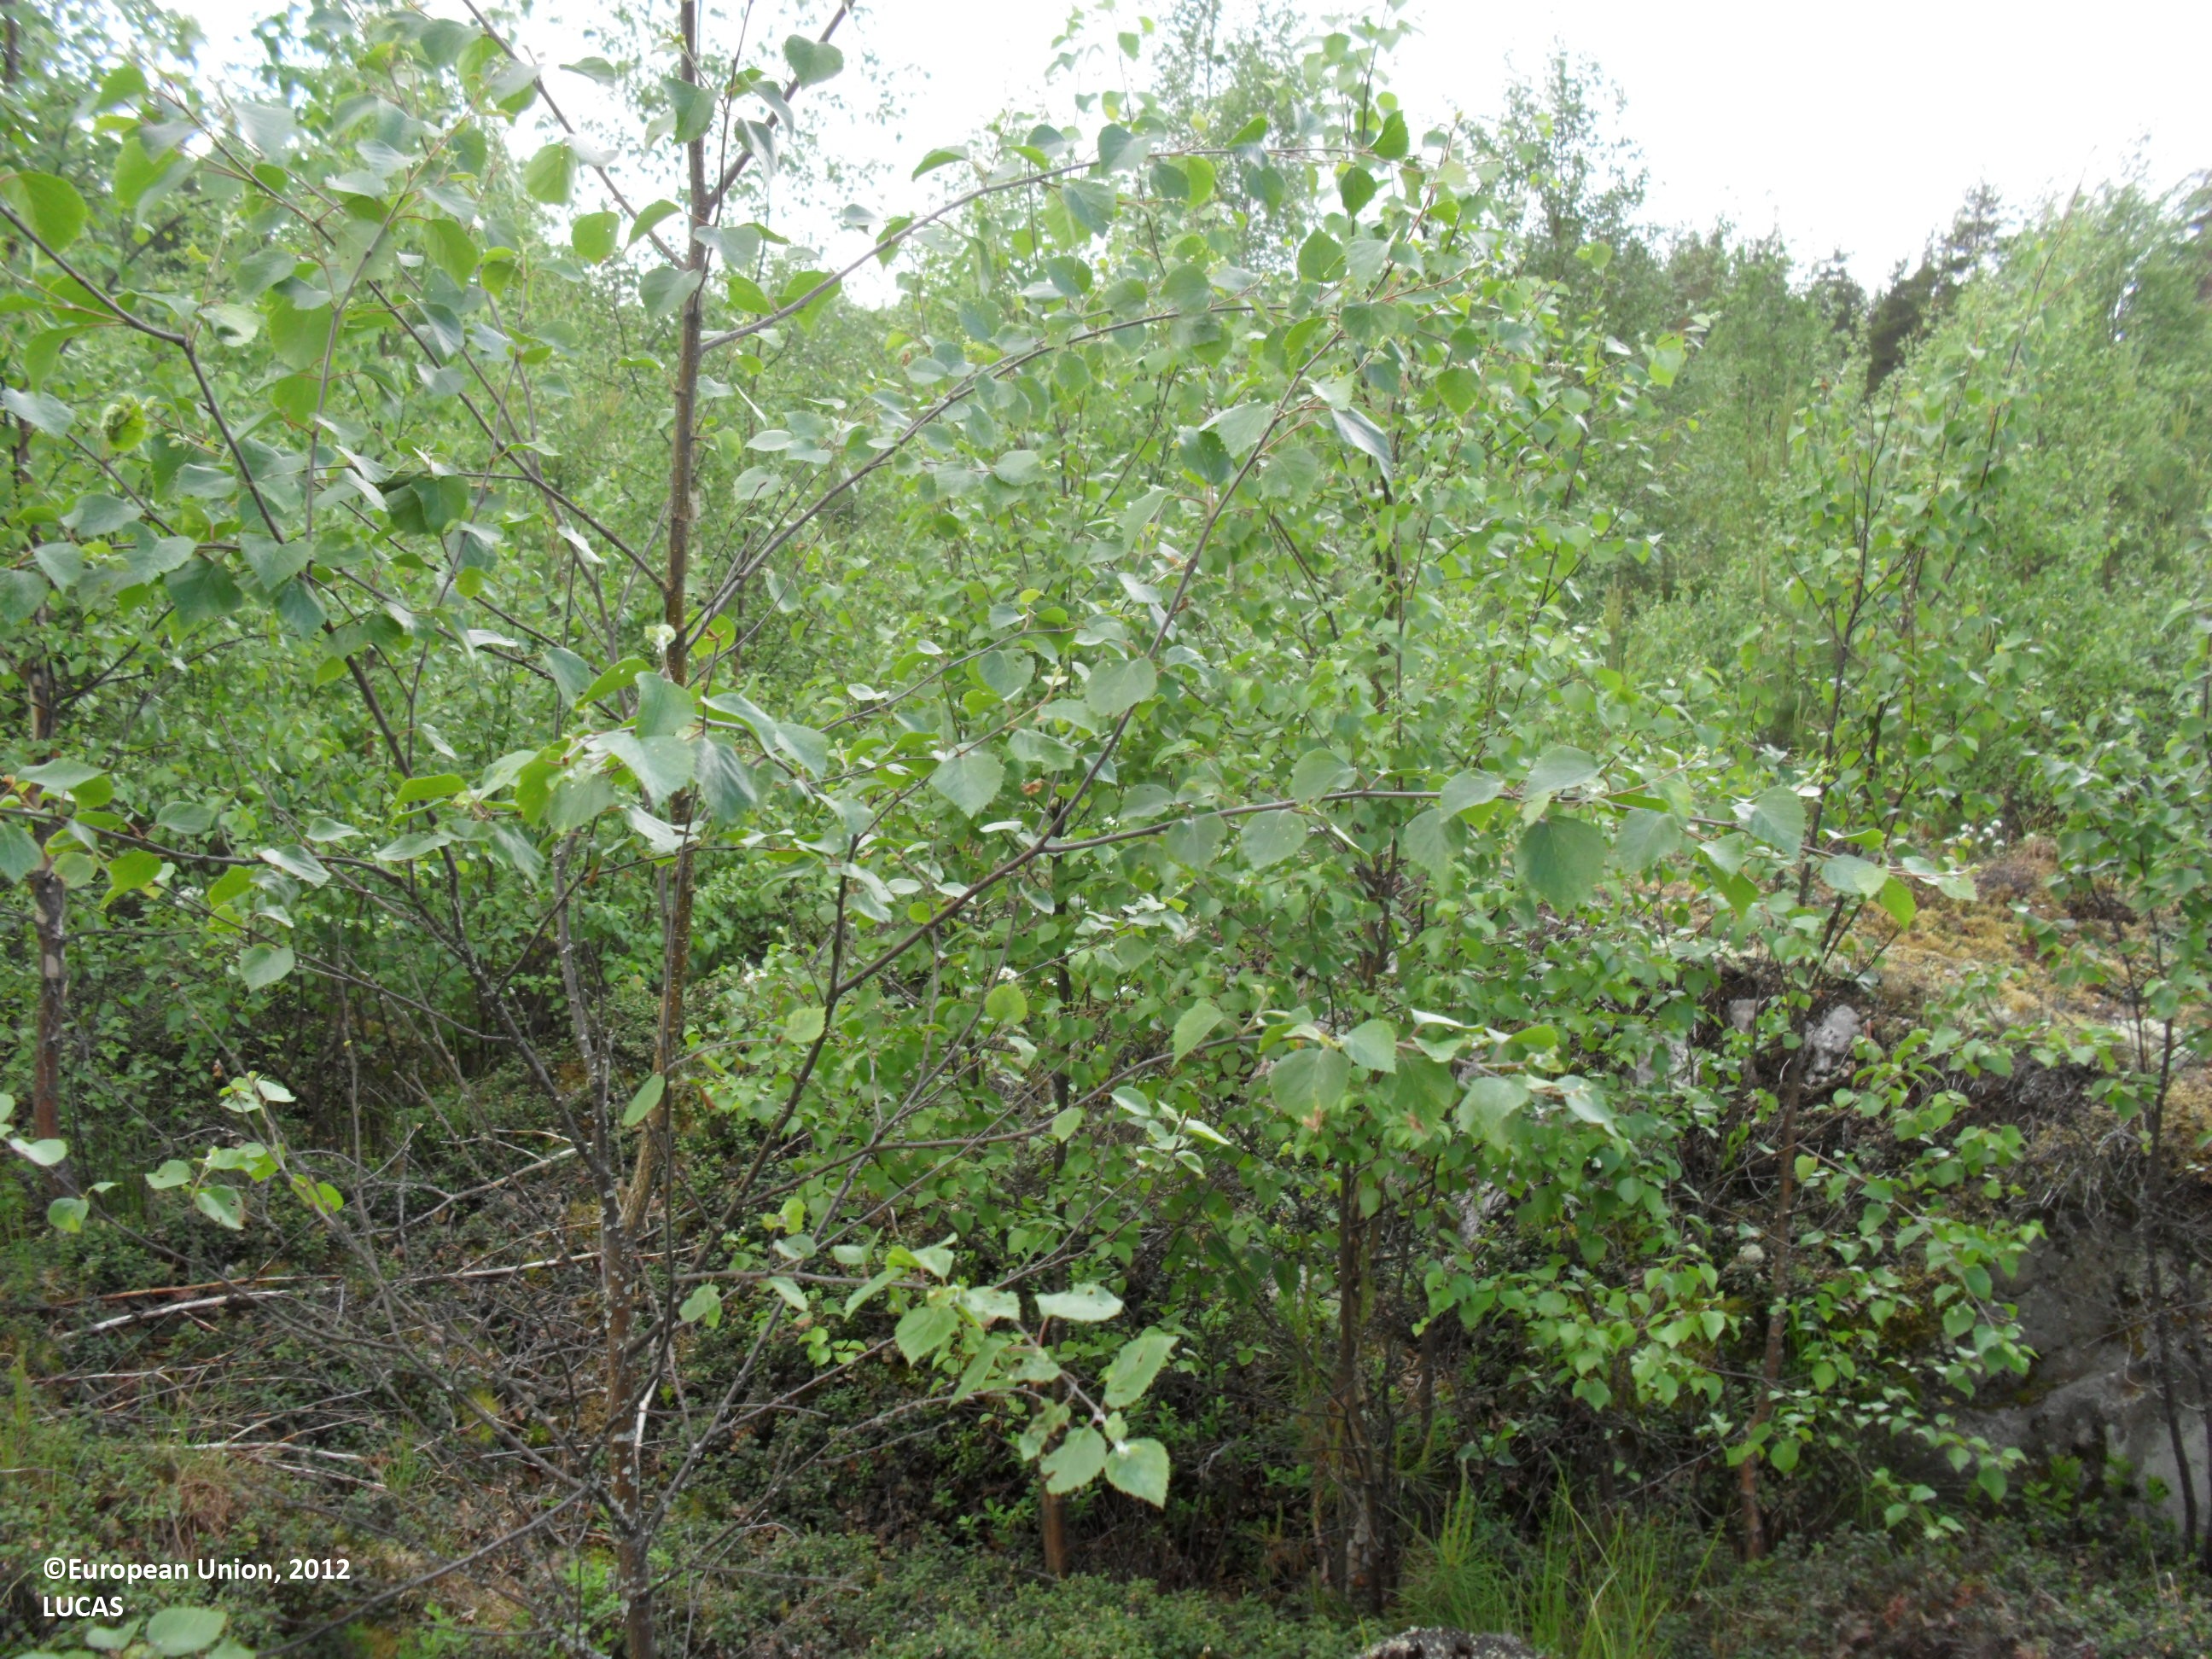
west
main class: Woodland
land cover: Other mixed woodland
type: boreal forest
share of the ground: 10 - 25 %
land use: Forestry
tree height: < 5 m
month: June
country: FI
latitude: 63.2225
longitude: 23.1702
